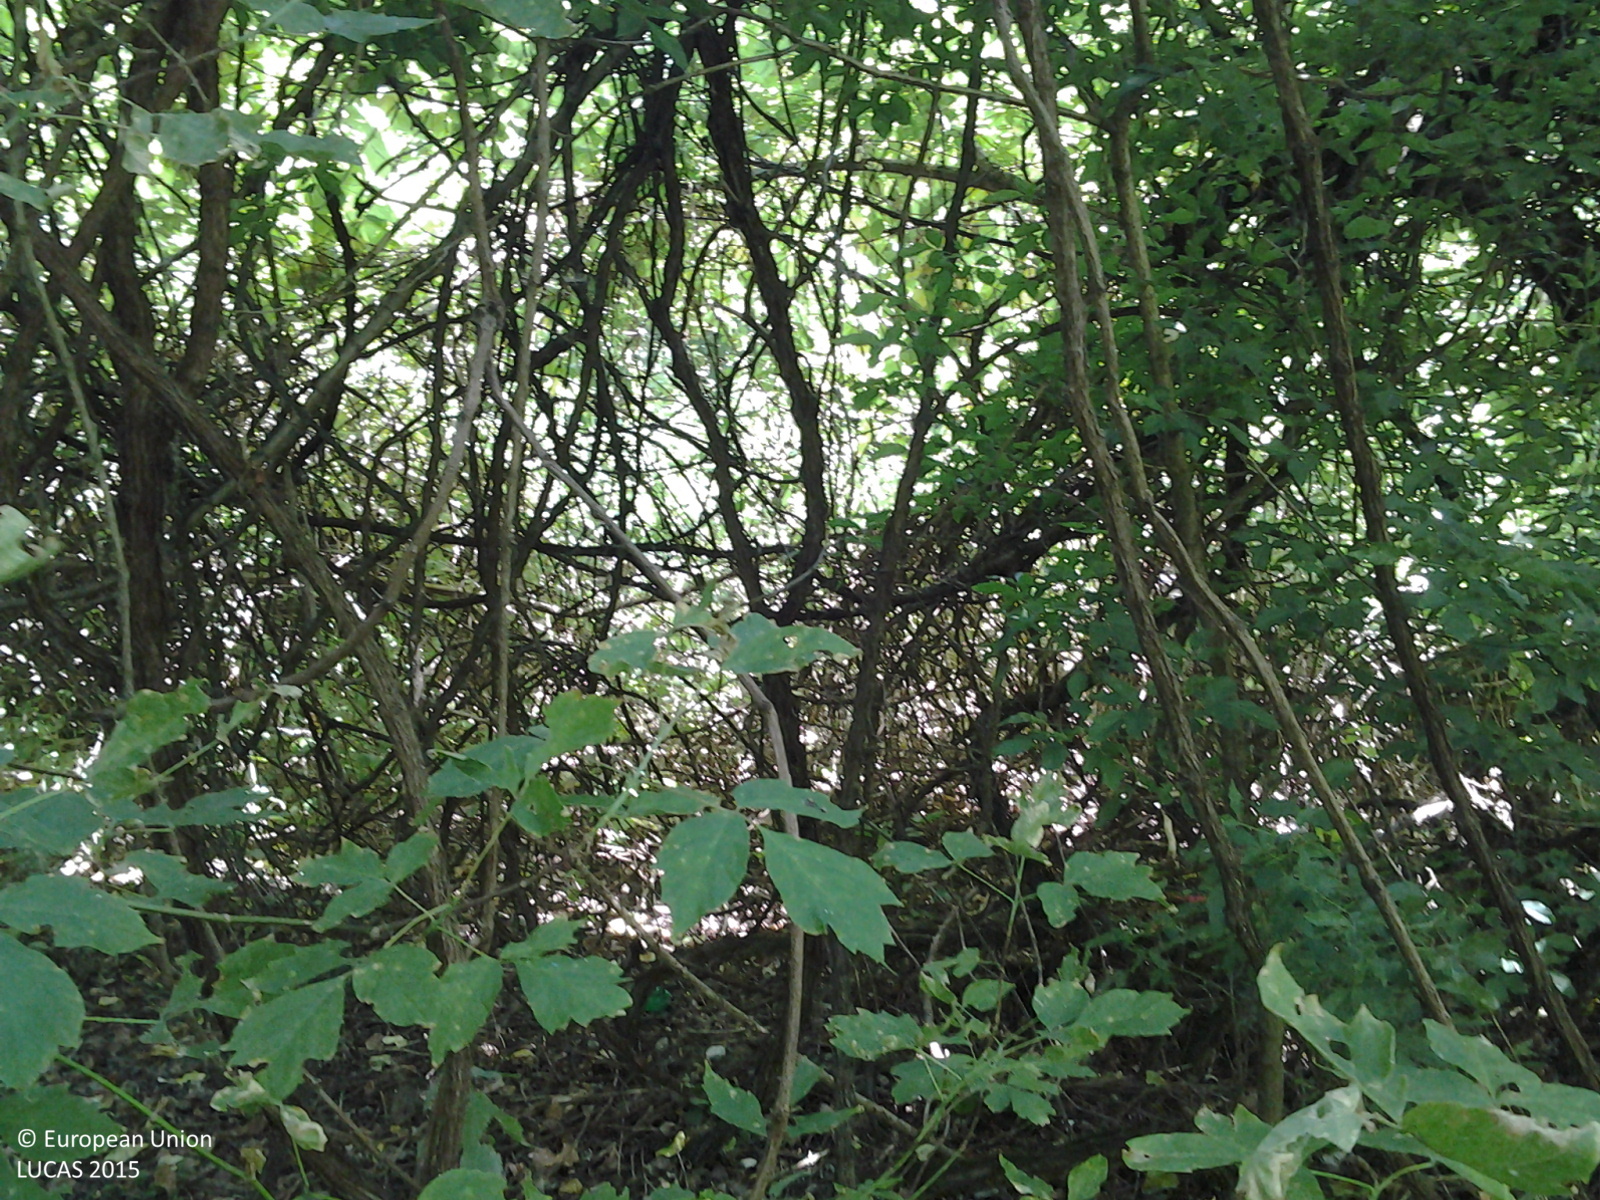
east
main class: Woodland
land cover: Broadleaved woodland
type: floodplain forest
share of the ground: > 75 %
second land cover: Spontaneously vegetated surfaces
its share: > 75 %
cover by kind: broadleaved forest trees 50 %, shrubs 40 %, herbaceous plants 10 %
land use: Forestry
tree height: > 5 m
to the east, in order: Broadleaved woodland; Spontaneously vegetated surfaces; Broadleaved woodland
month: July
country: HU
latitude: 47.4210
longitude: 20.4087
